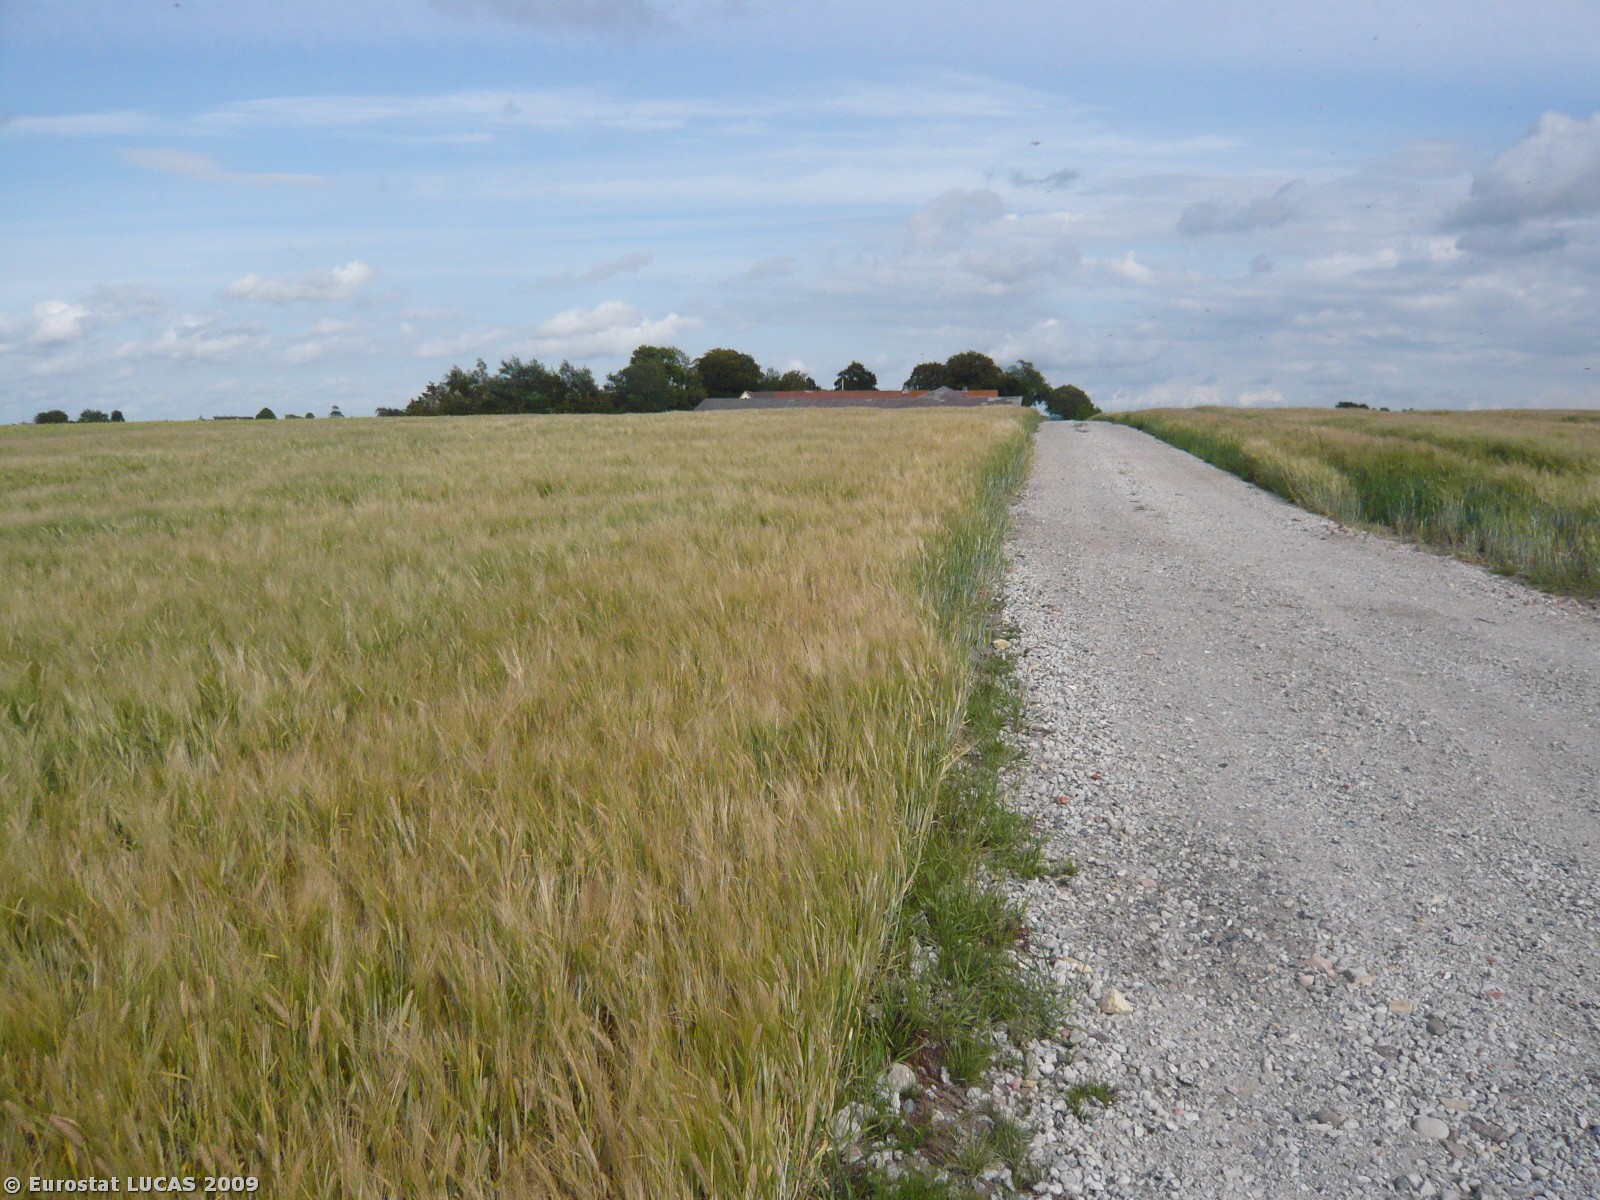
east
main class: Cropland
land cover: Barley
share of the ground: > 75 %
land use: Agriculture (excluding fallow land and kitchen gardens)
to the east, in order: Barley; Common wheat
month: July
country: DK
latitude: 55.4267
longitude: 11.2472
